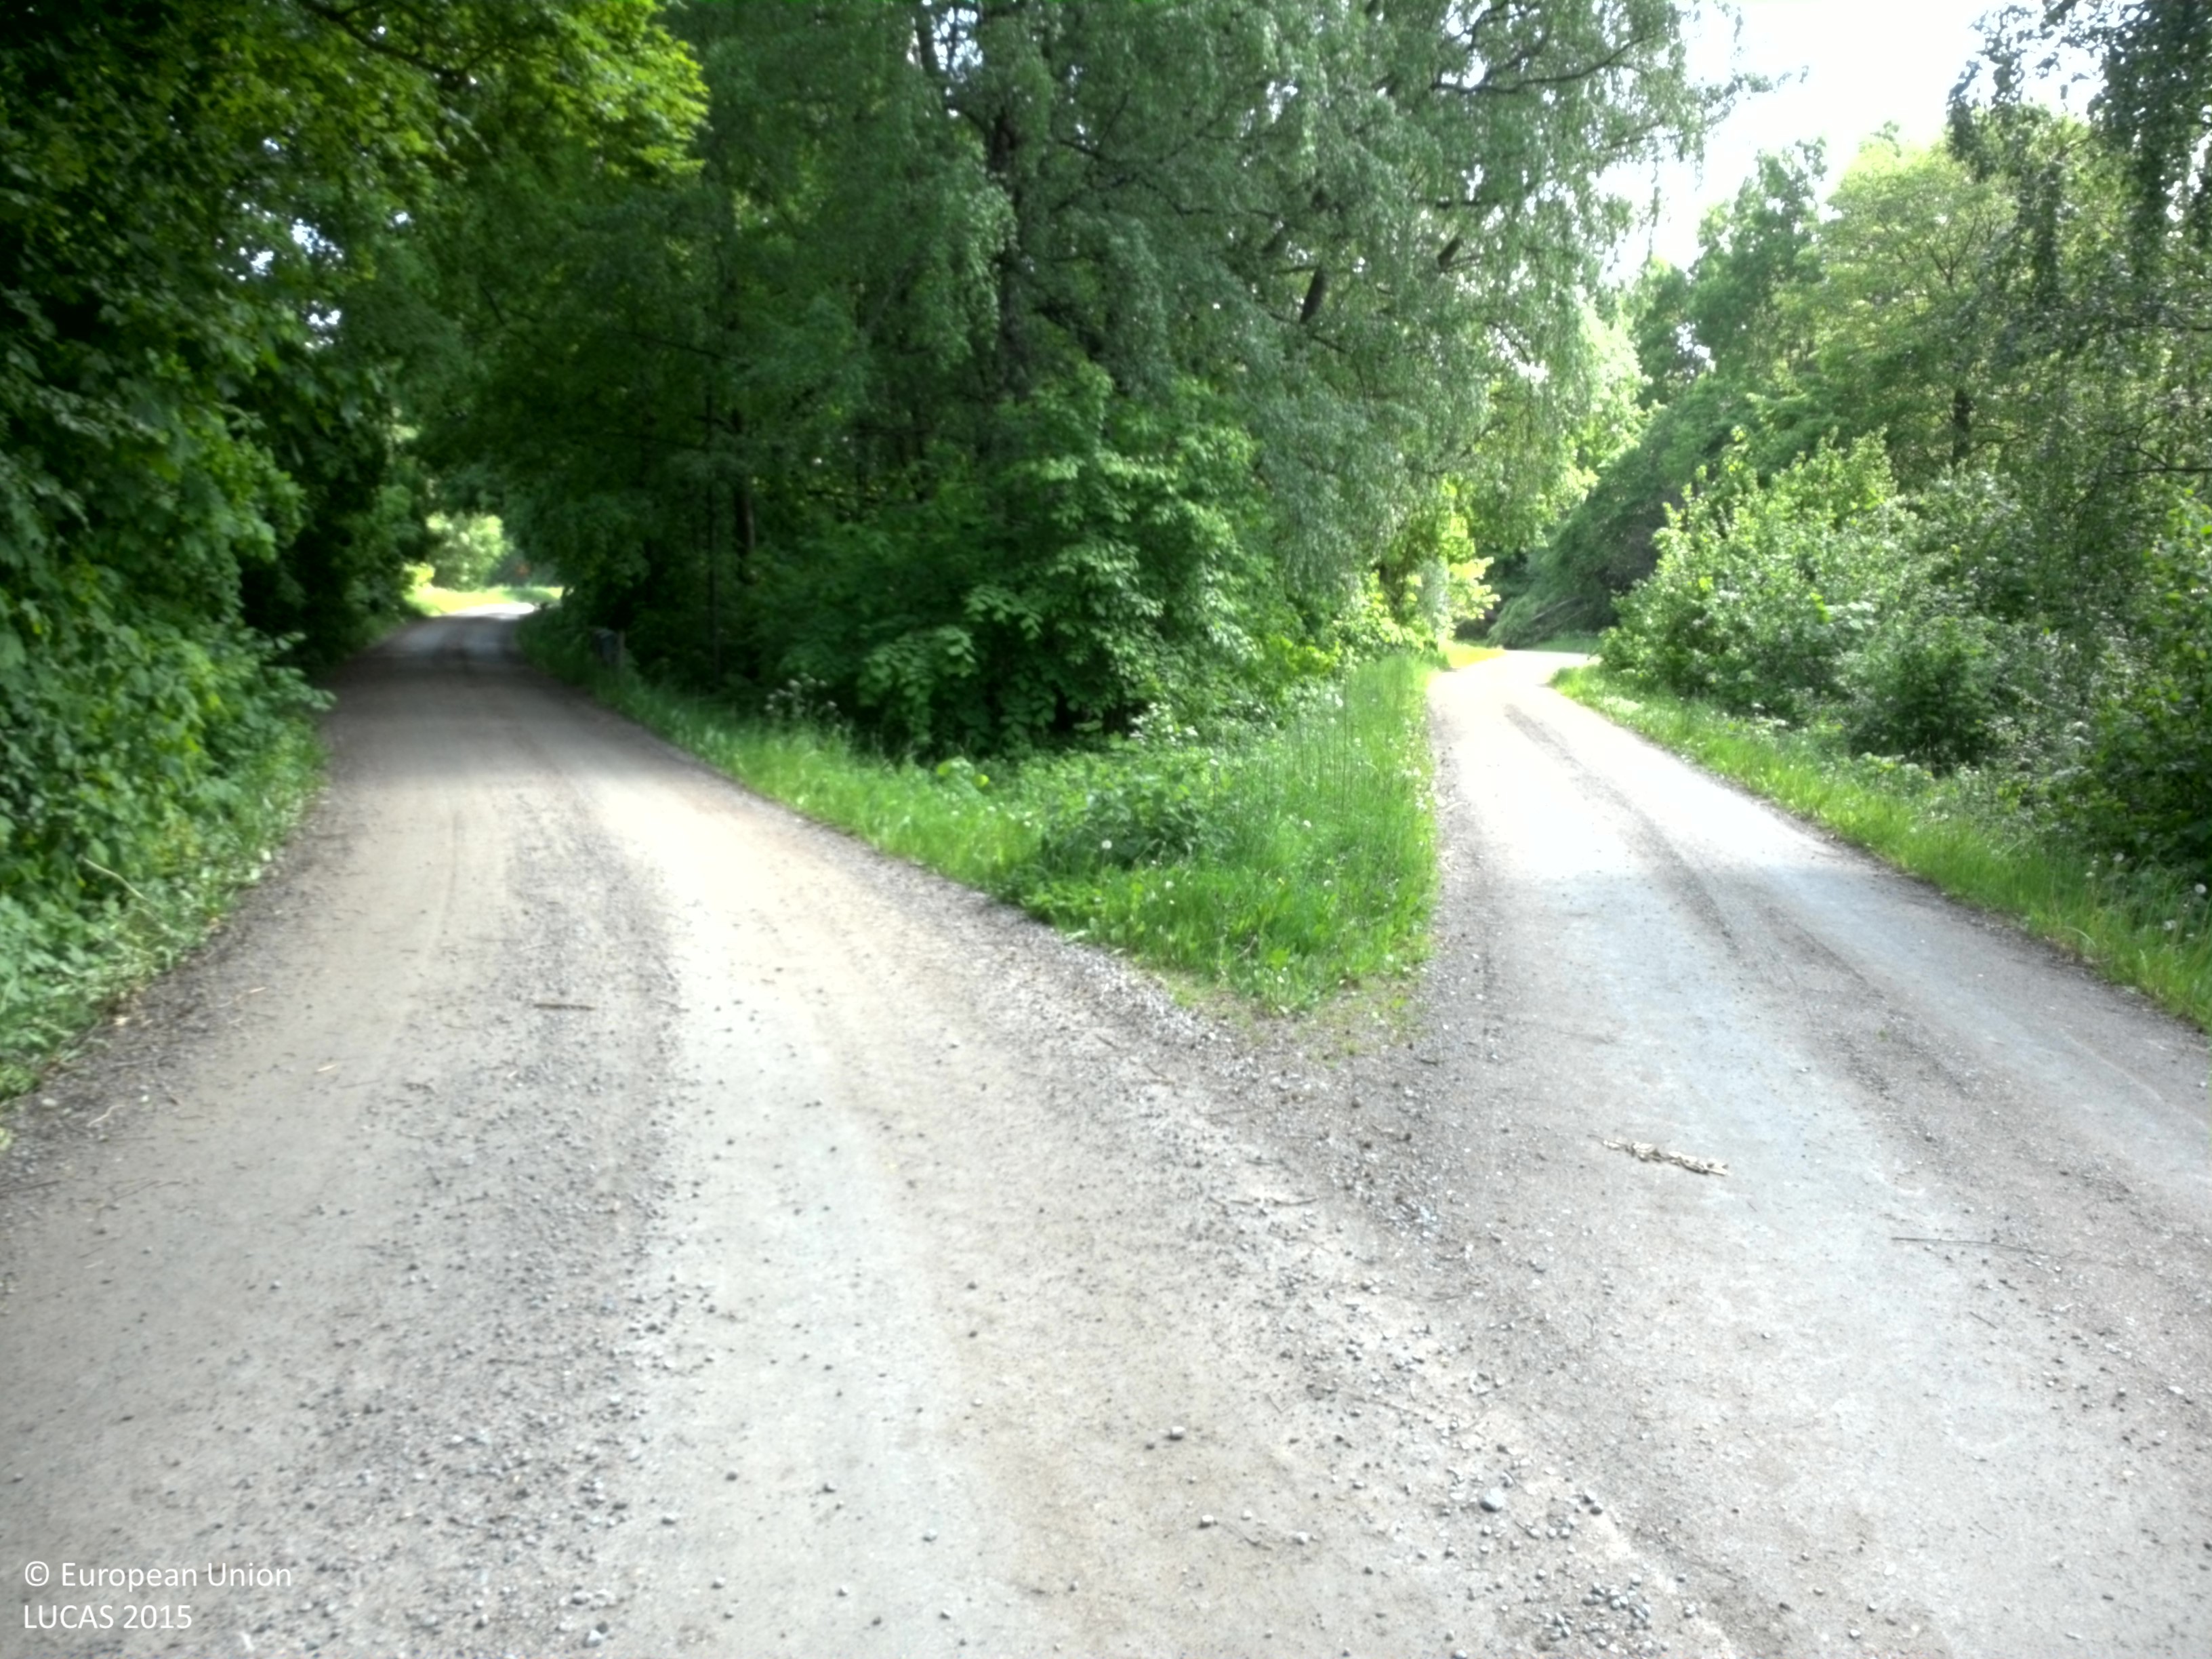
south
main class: Woodland
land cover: Broadleaved woodland
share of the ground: > 75 %
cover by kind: broadleaved forest trees 90 %, herbaceous plants 10 %
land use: Residential
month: June
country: SE
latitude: 58.4871
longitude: 15.4659
